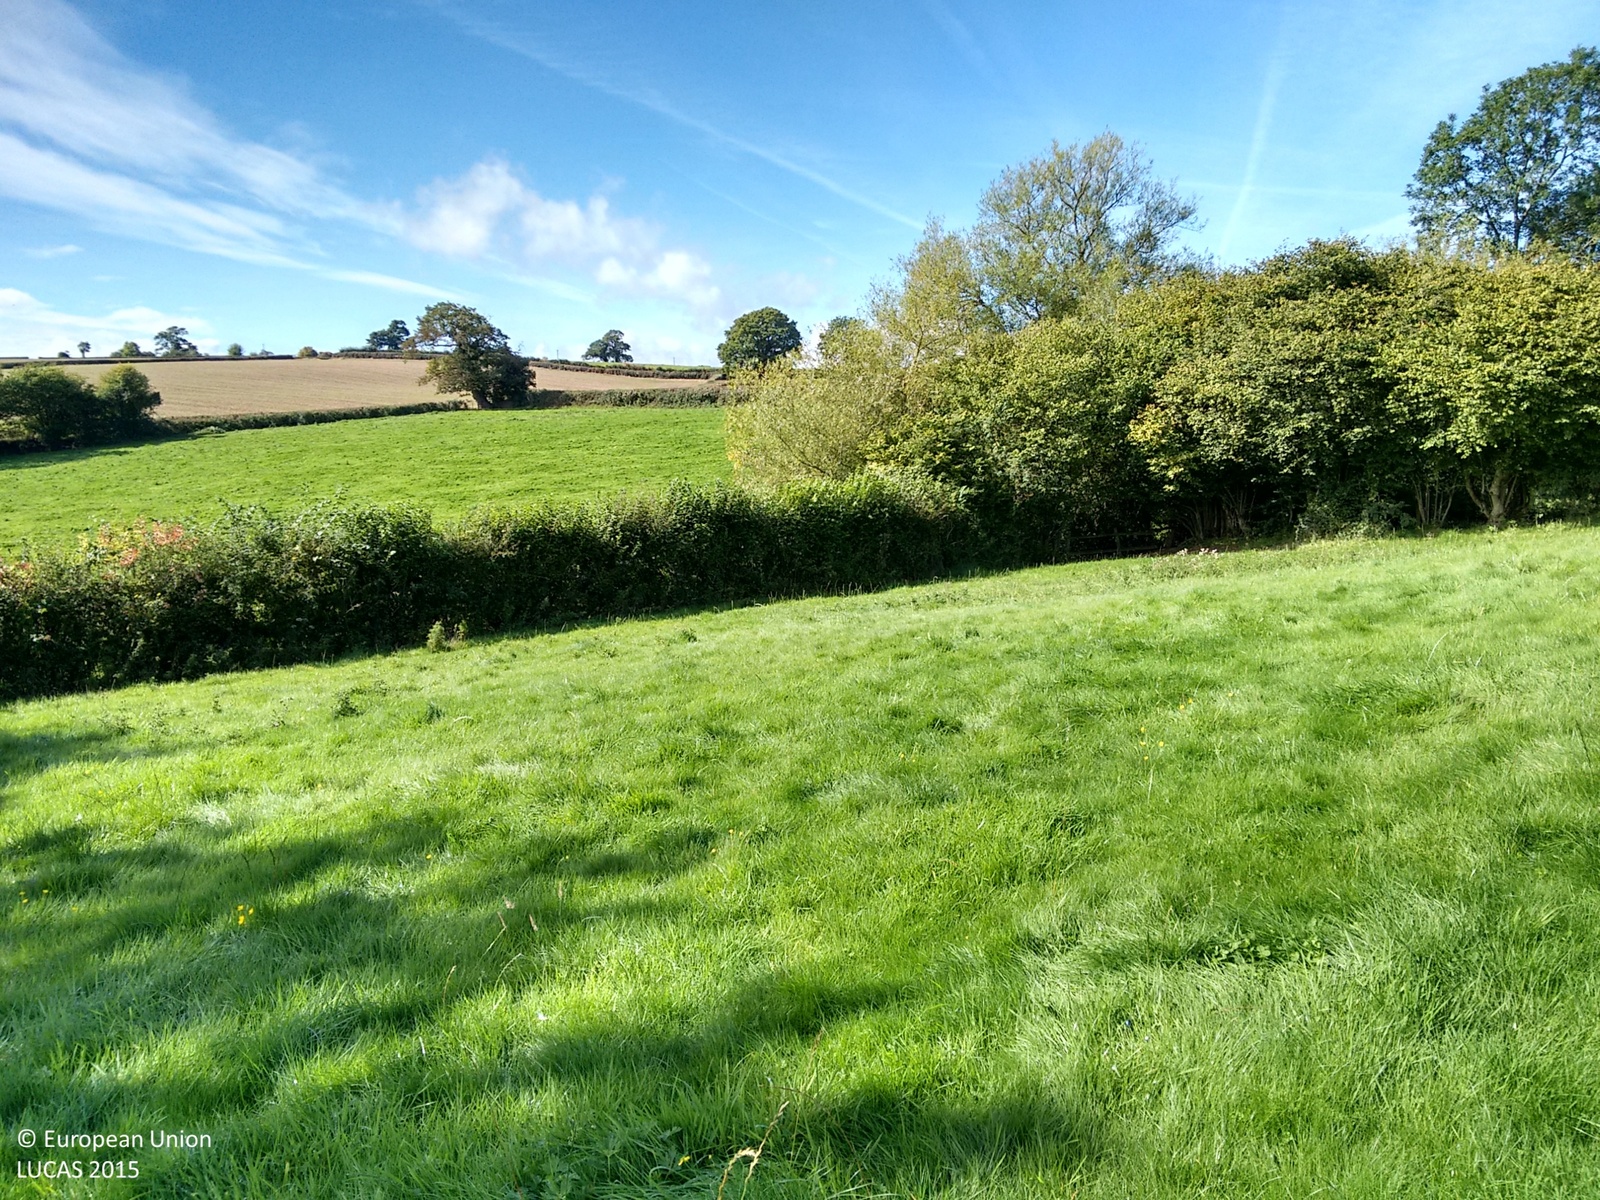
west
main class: Grassland
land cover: Grassland without tree/shrub cover
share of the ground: > 75 %
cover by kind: herbaceous plants 100 %
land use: Agriculture (excluding fallow land and kitchen gardens)
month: September
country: GB
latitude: 51.8320
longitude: -2.9163
